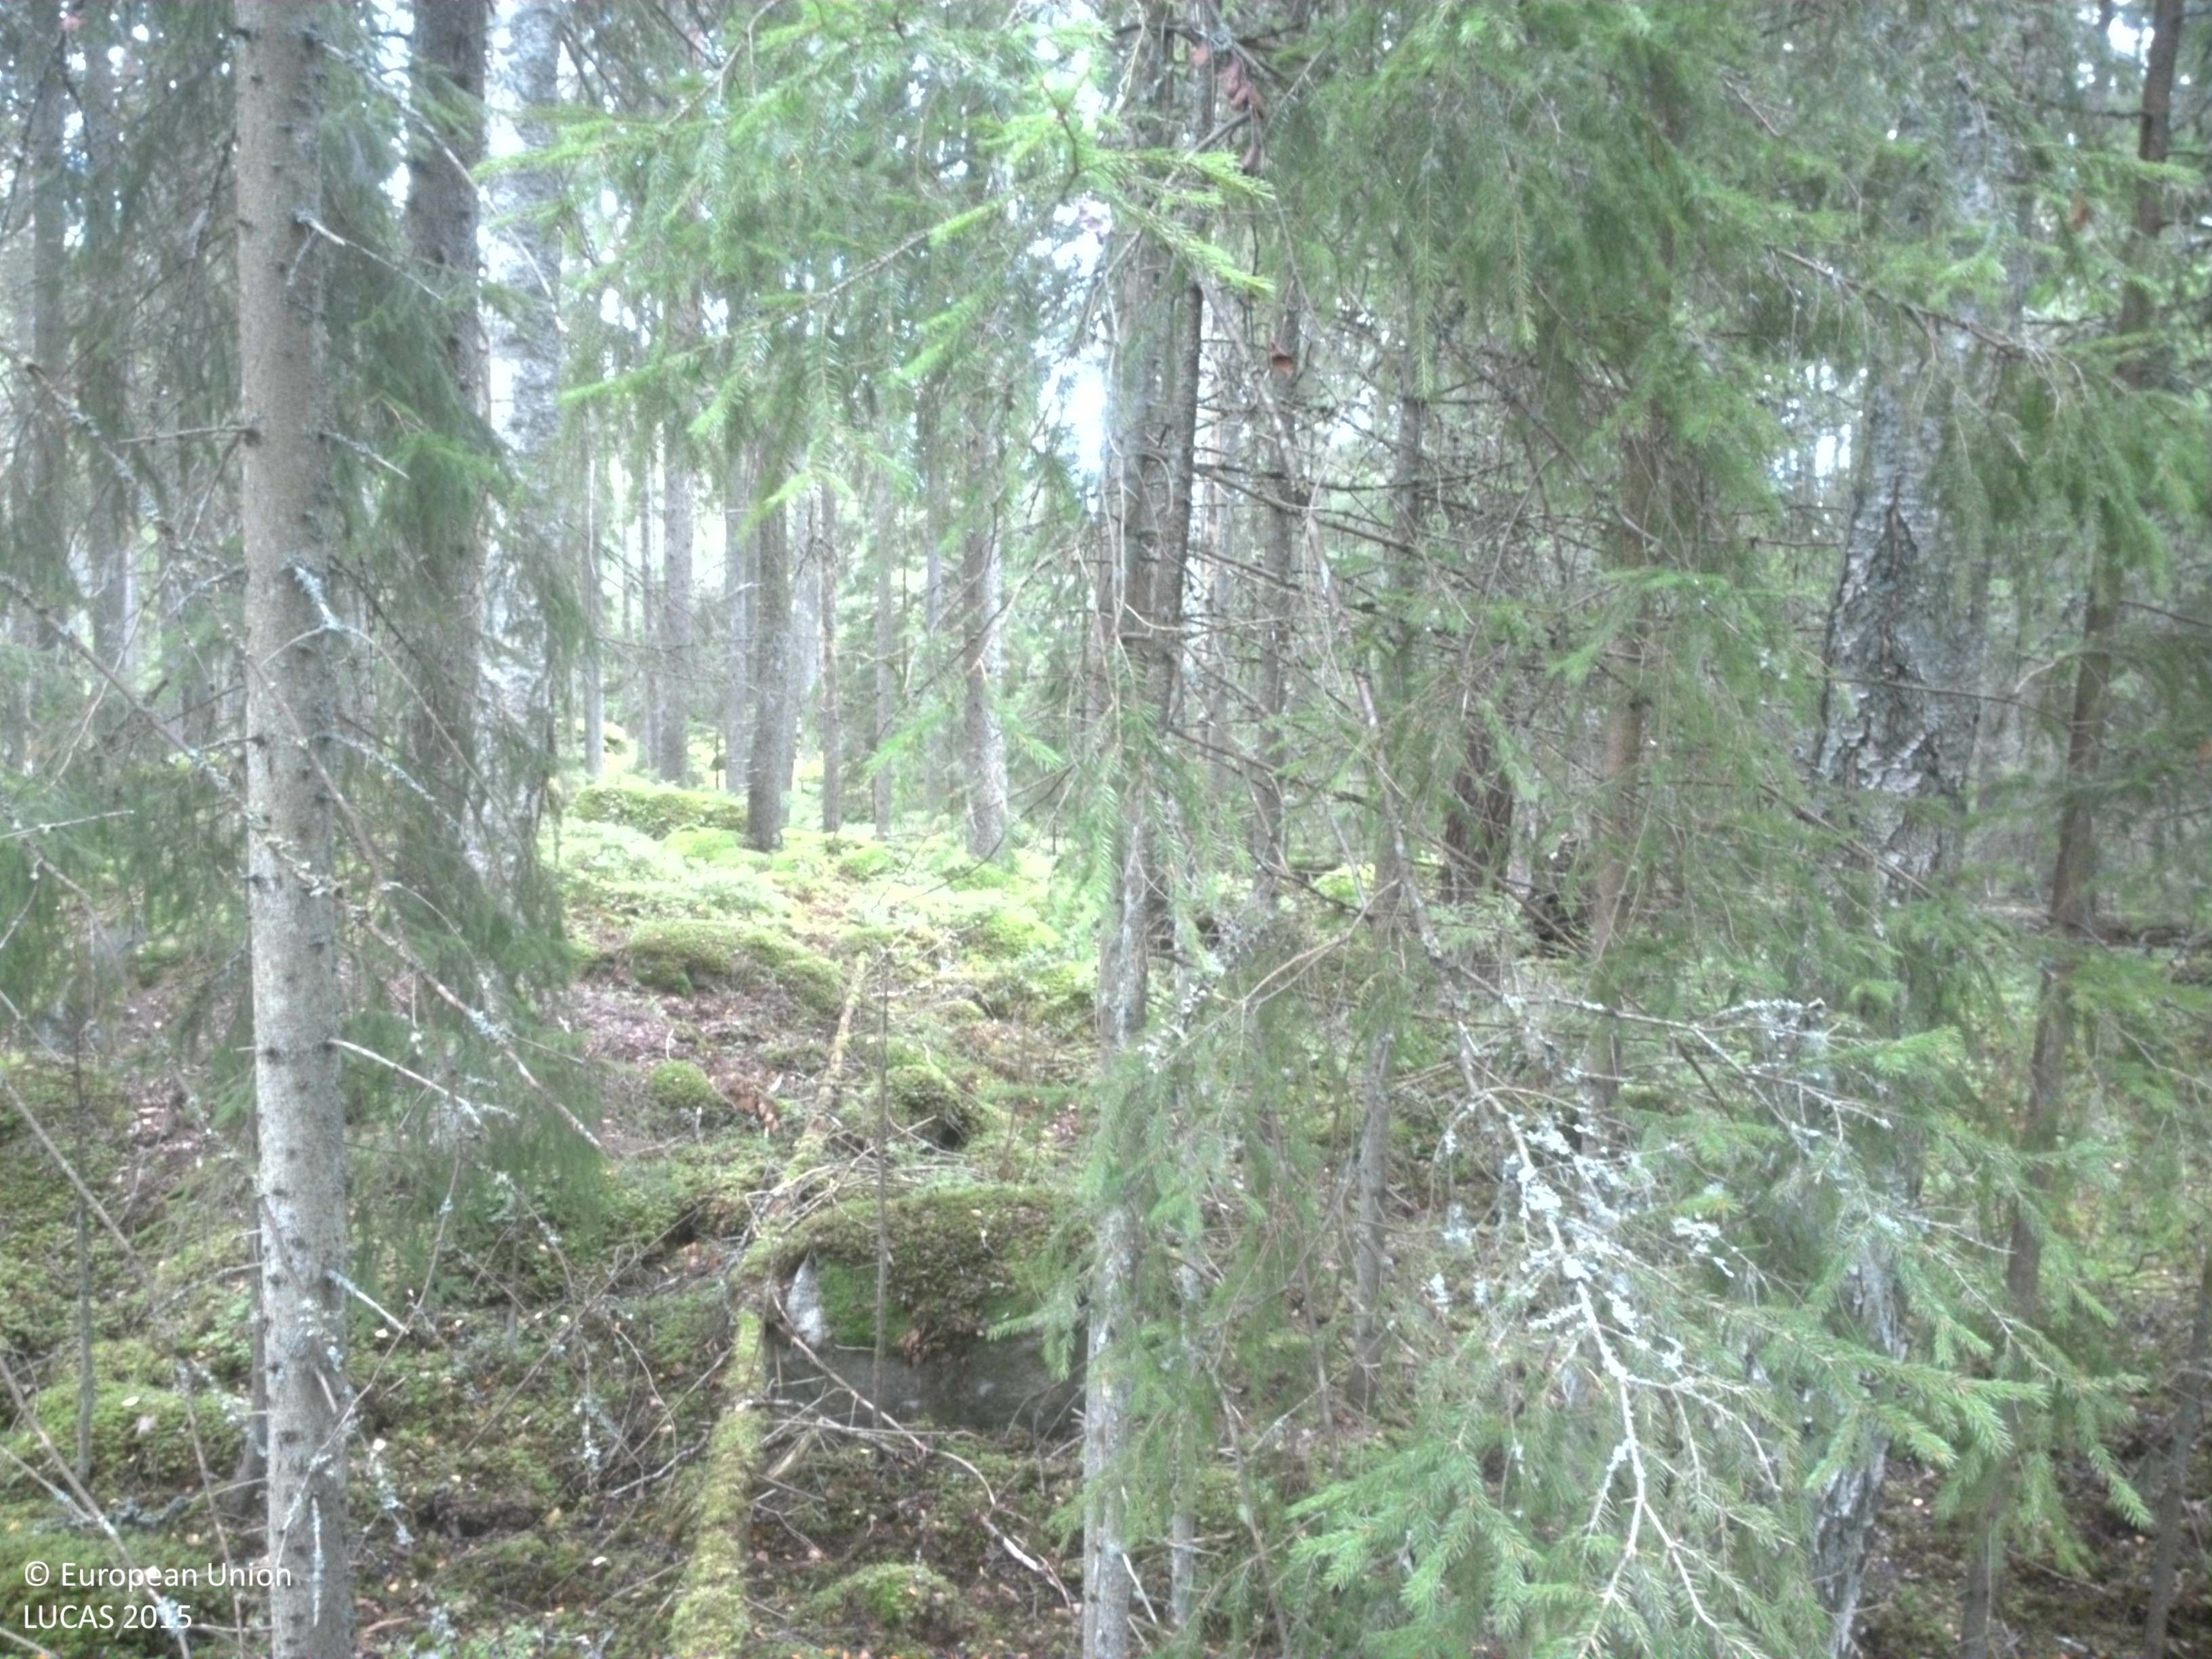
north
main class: Woodland
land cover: Spruce dominated coniferous woodland
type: boreal forest
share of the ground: > 75 %
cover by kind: coniferous forest trees 75 %, lichens and mosses 20 %, shrubs 5 %
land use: Forestry
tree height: > 5 m
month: September
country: SE
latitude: 59.5211
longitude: 15.7711
